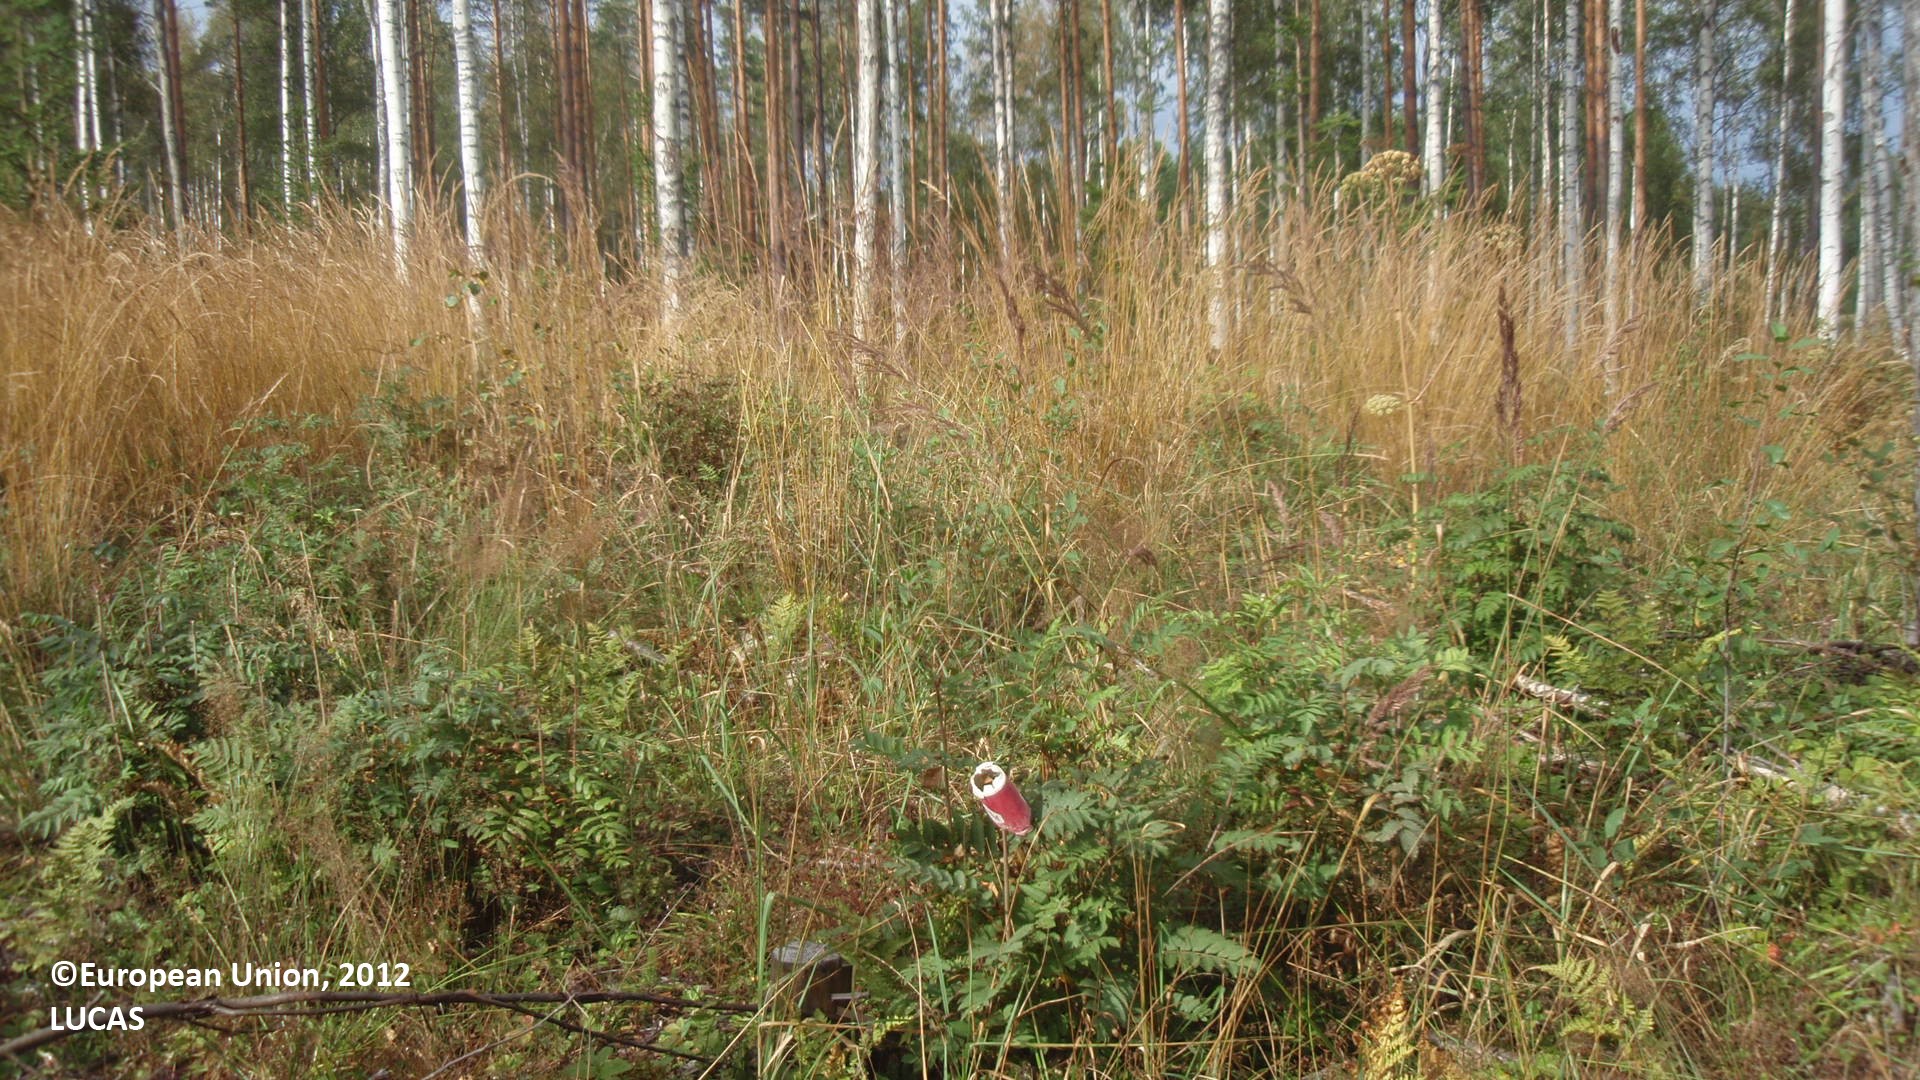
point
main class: Woodland
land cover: Broadleaved woodland
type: non-riverine alder, birch or aspen forest
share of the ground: 50 - 75 %
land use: Forestry
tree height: > 5 m
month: August
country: FI
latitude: 61.1540
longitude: 26.6739
